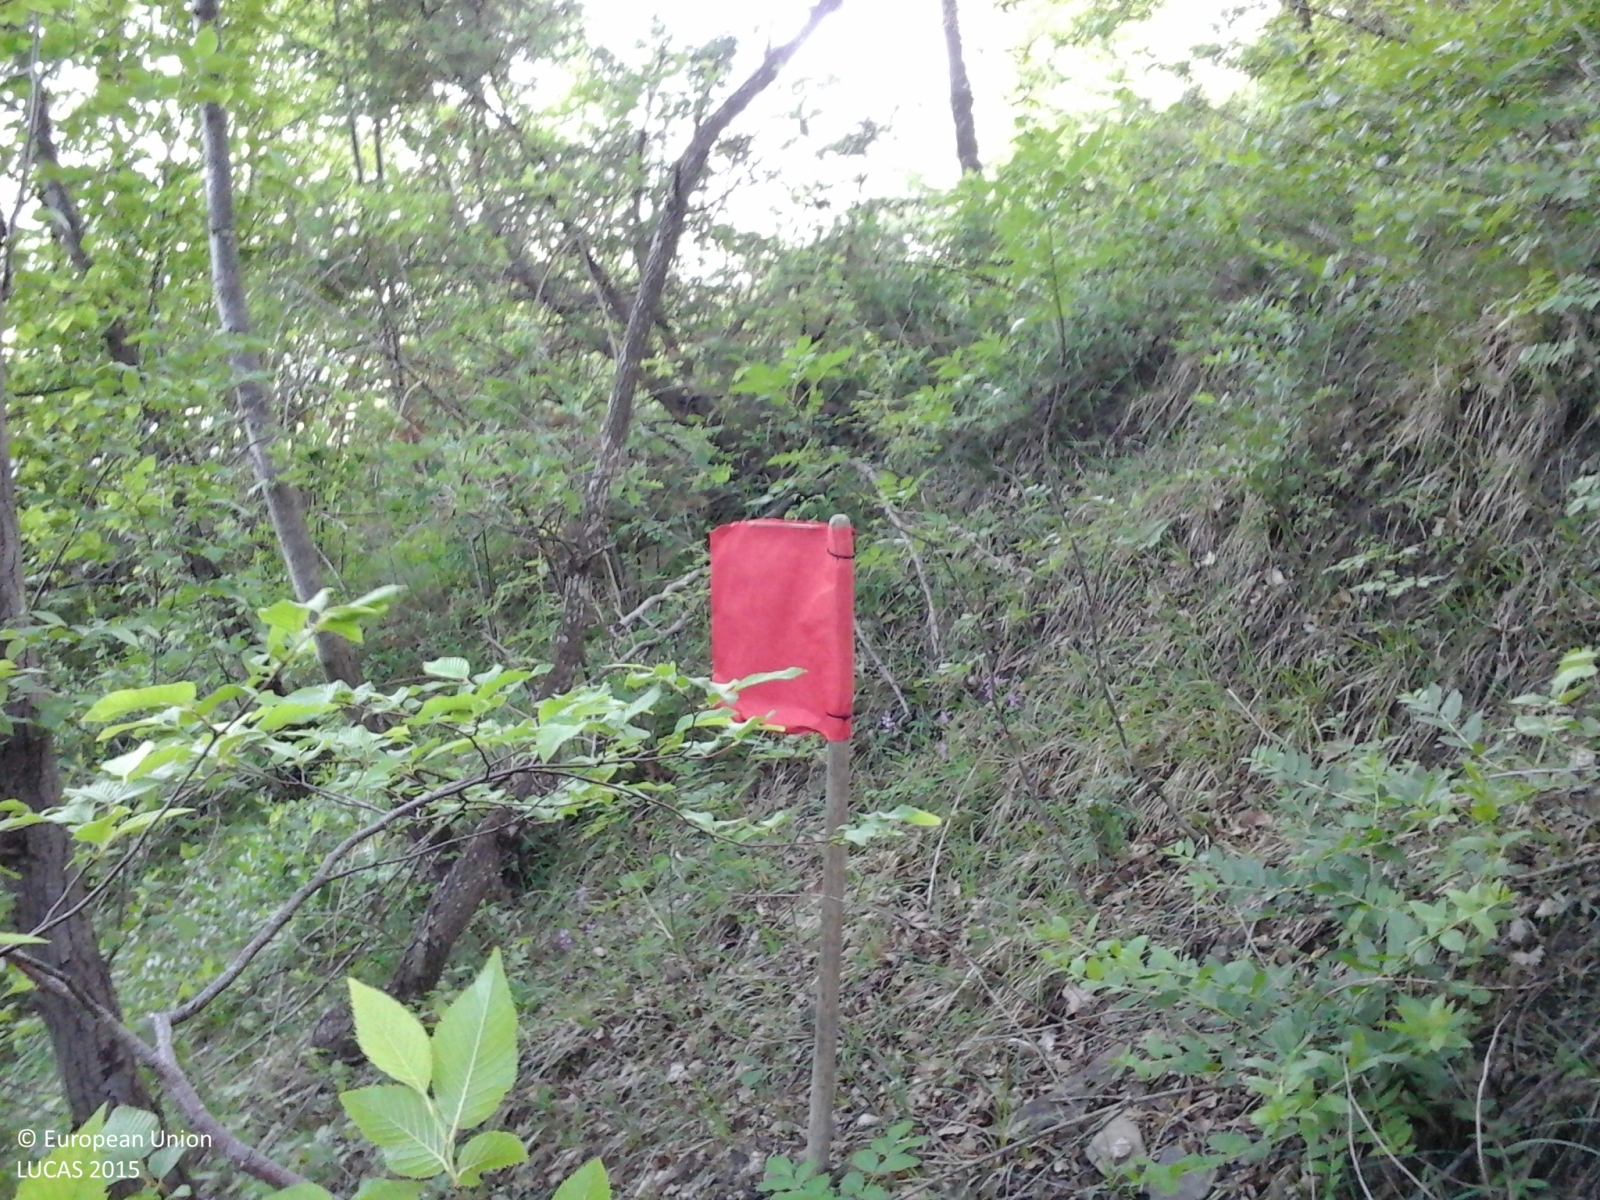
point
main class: Woodland
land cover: Broadleaved woodland
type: thermophilous deciduous forest
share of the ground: > 75 %
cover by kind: broadleaved forest trees 100 %
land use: Forestry
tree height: > 5 m
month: May
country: IT
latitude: 44.5309
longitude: 9.9121
